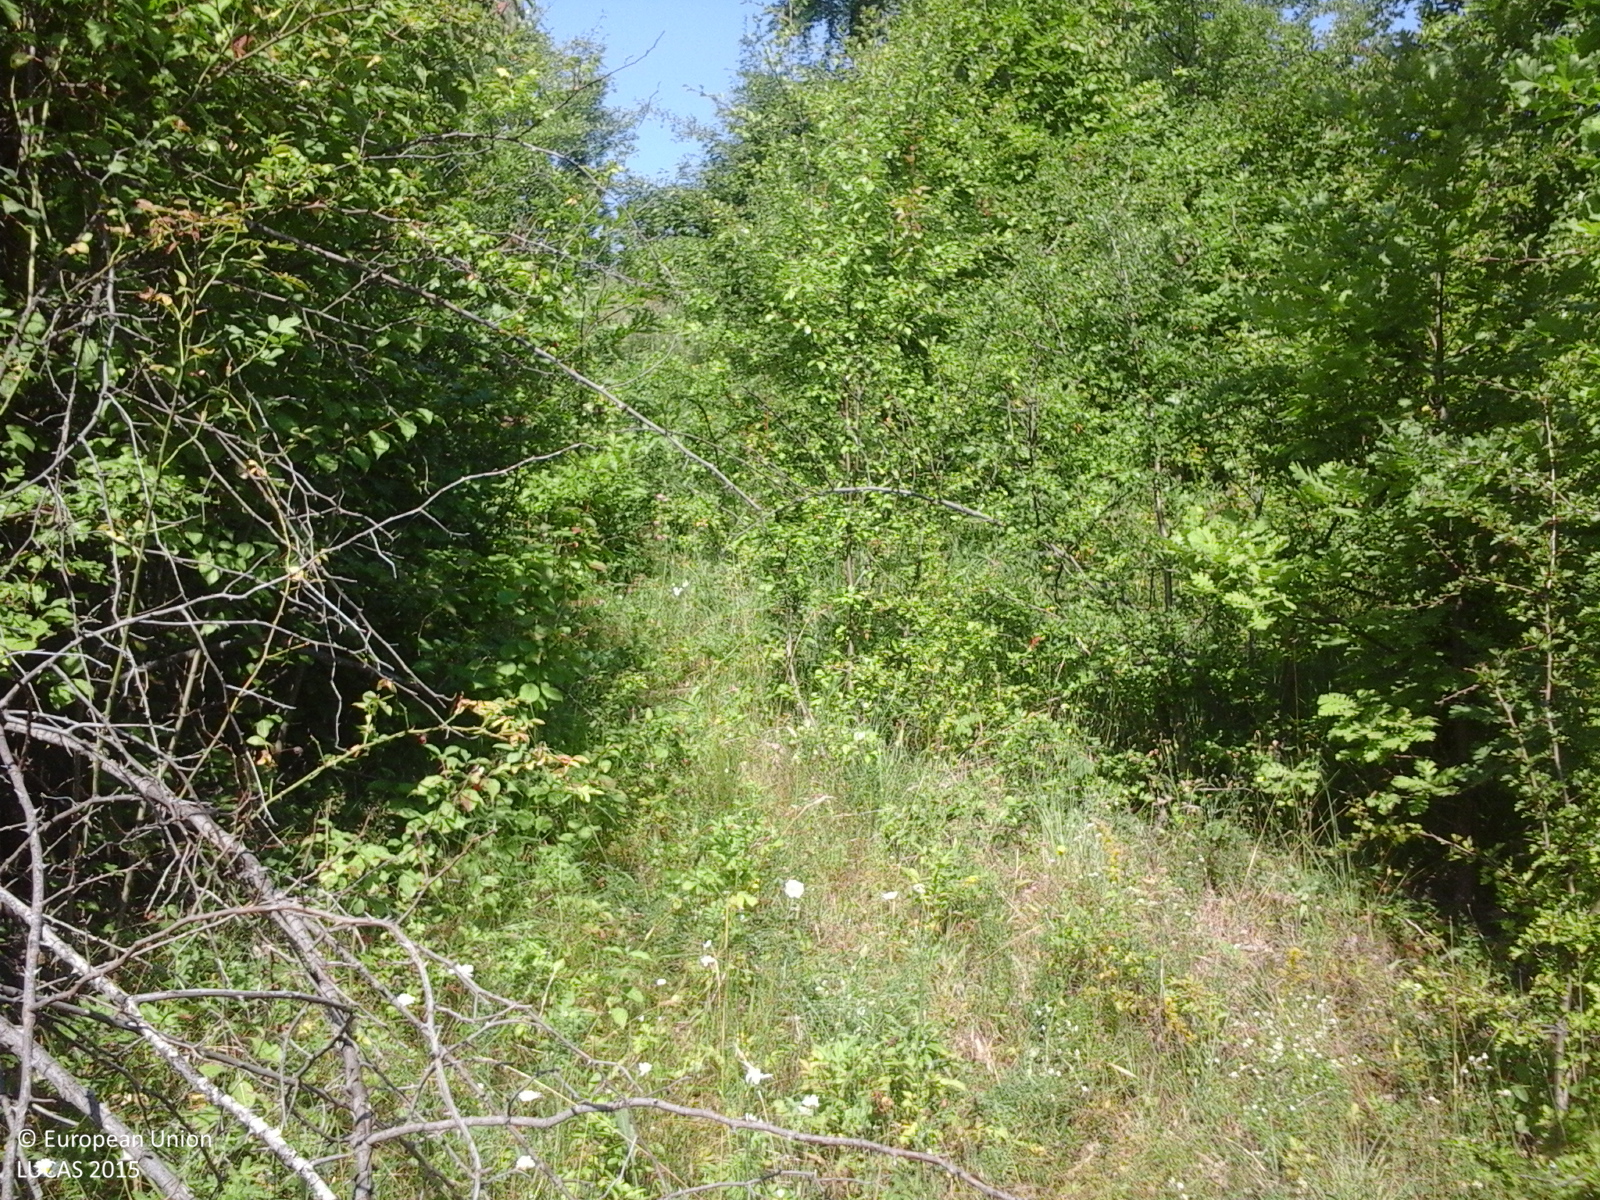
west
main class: Woodland
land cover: Broadleaved woodland
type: acidophilous oak and oak-birch forest
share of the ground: > 75 %
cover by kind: broadleaved forest trees 100 %
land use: Forestry
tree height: > 5 m
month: July
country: RO
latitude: 44.7975
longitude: 24.5748
